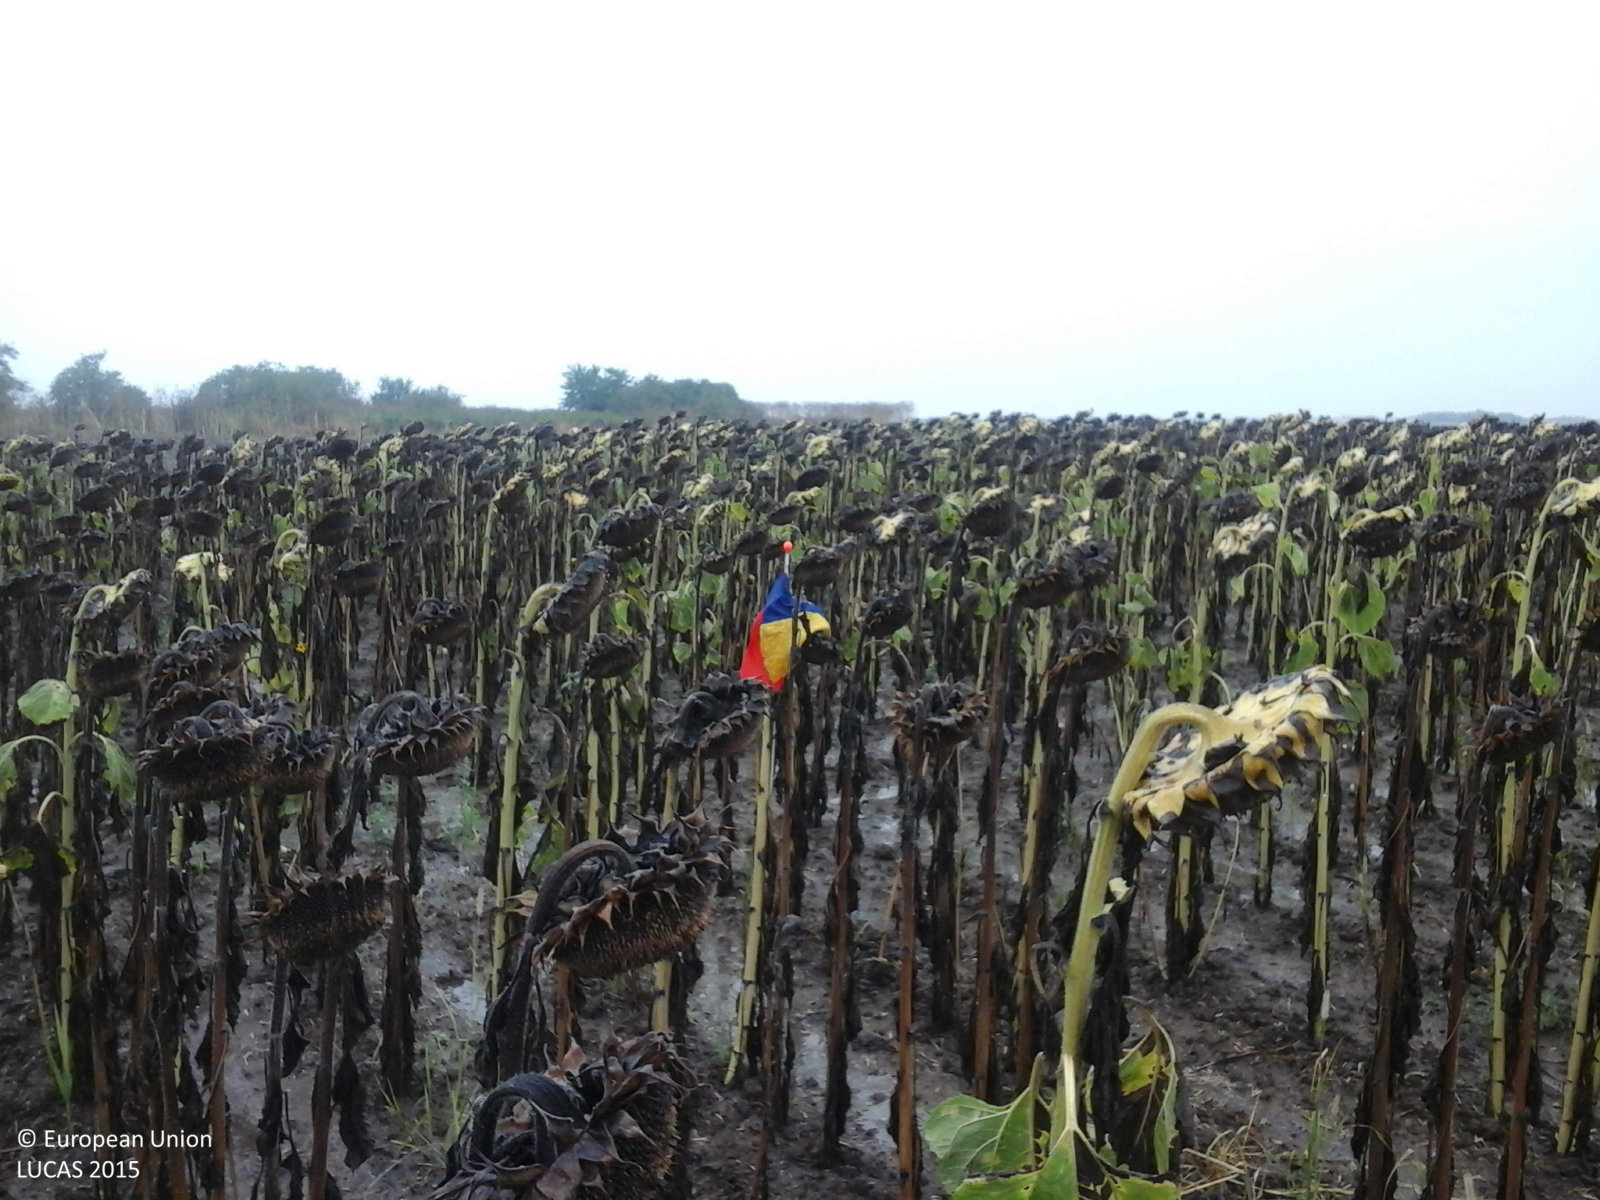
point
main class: Cropland
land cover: Sunflower
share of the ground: > 75 %
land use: Agriculture (excluding fallow land and kitchen gardens)
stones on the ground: 10 - 25 %
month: August
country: RO
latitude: 45.6620
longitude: 21.1048
